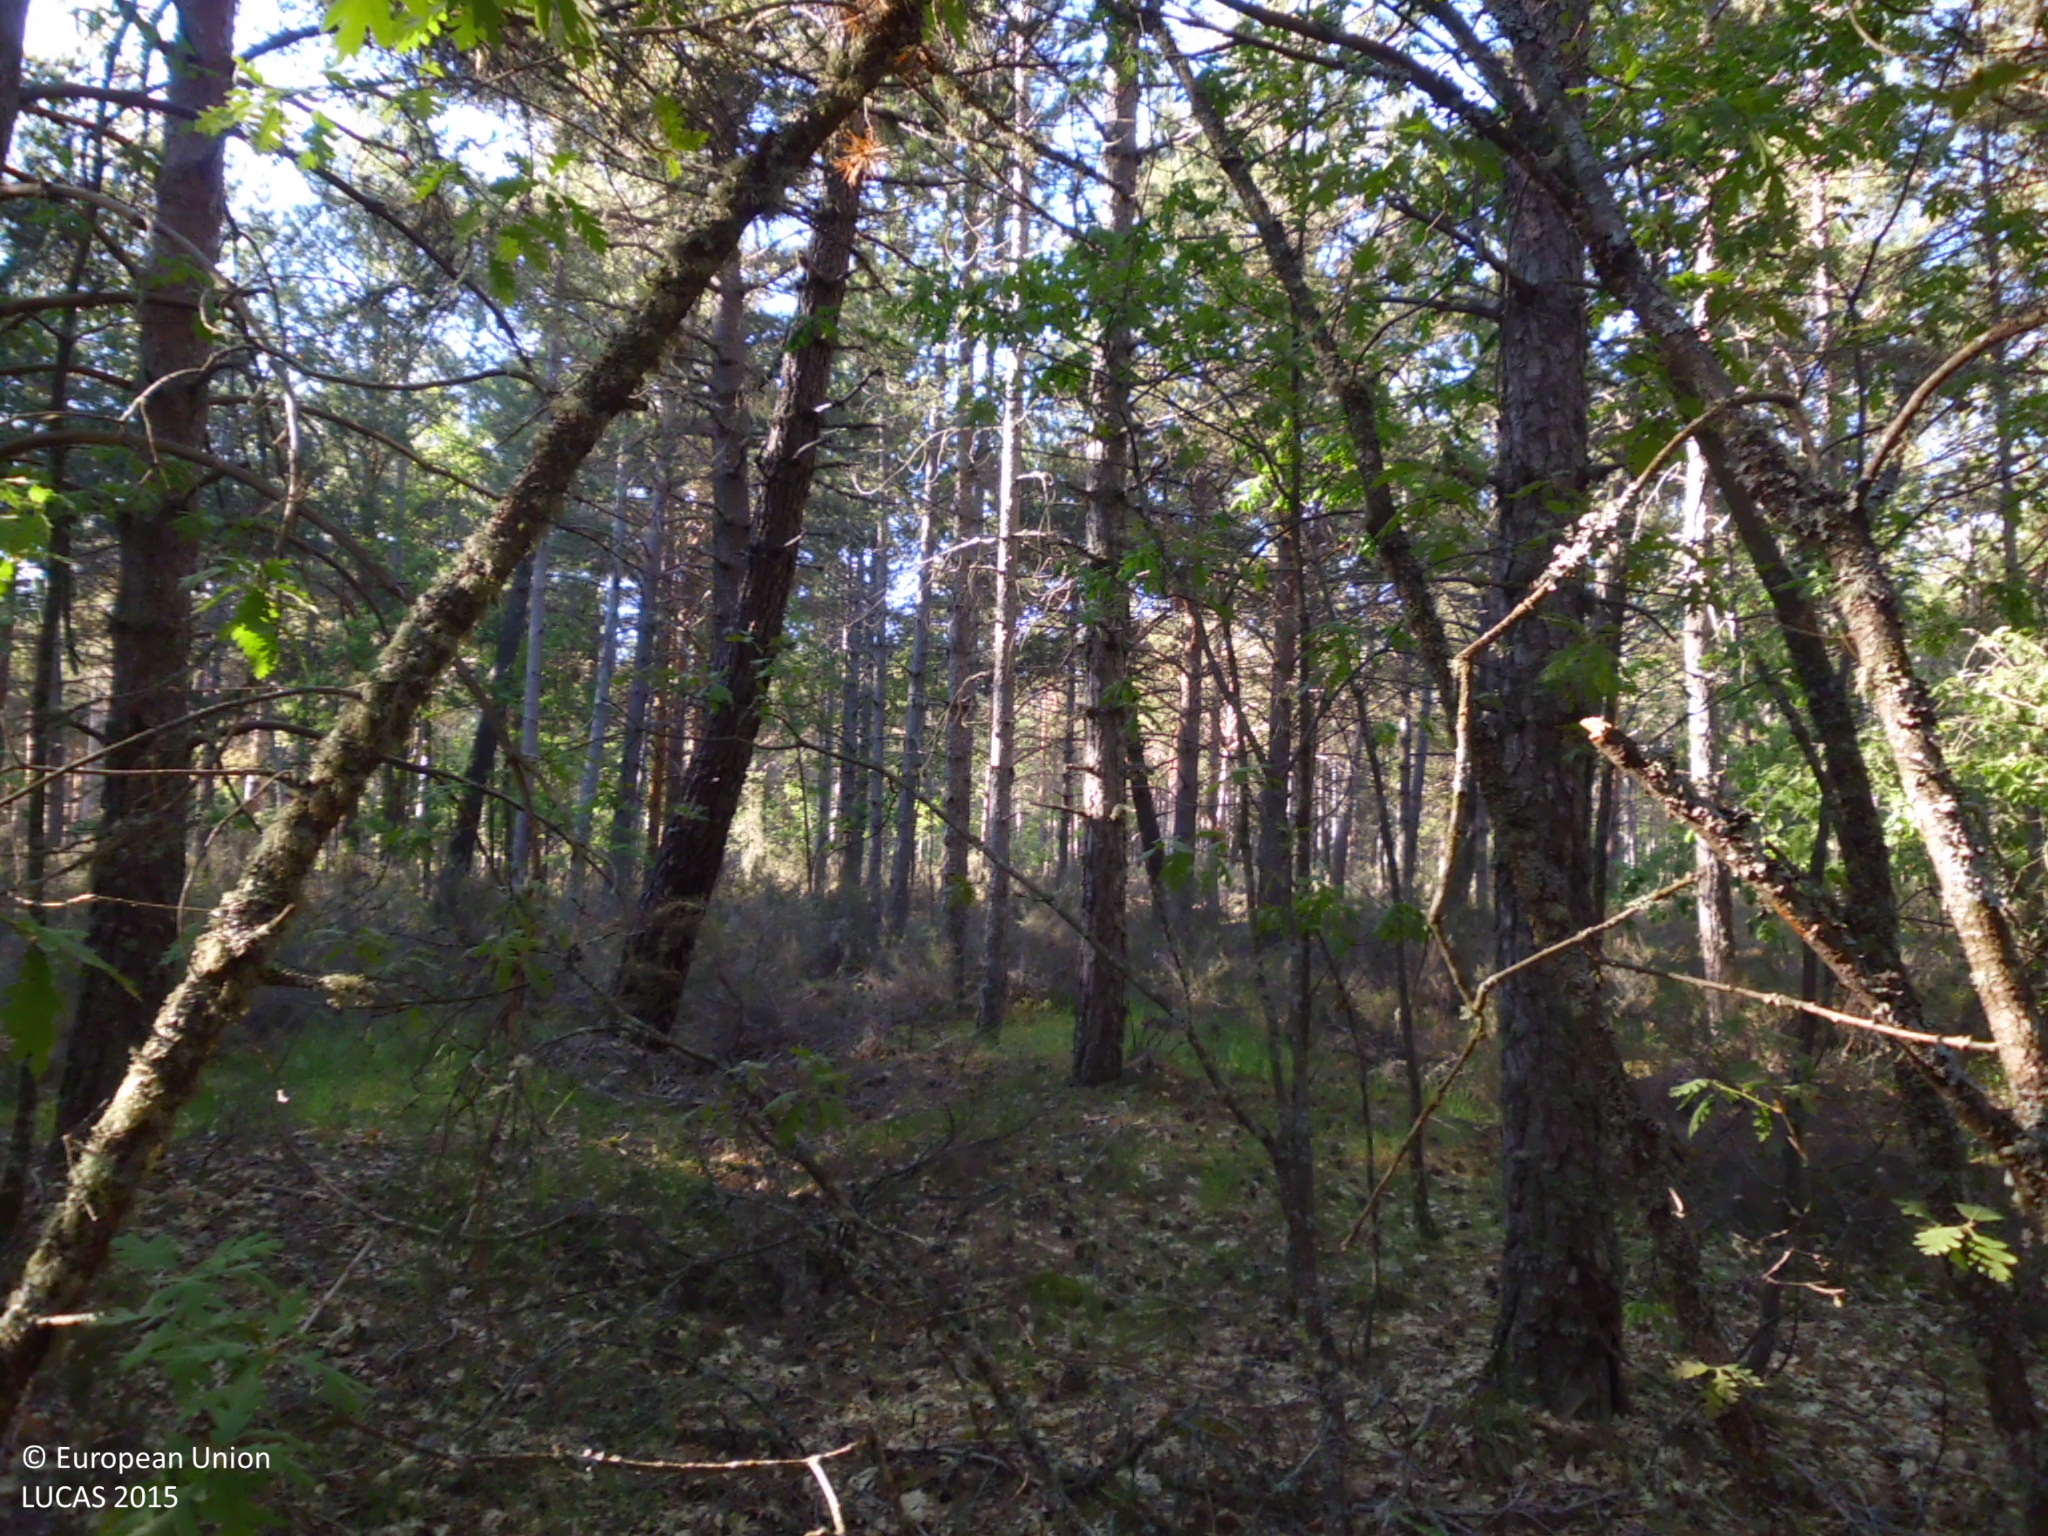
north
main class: Woodland
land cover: Pine dominated coniferous woodland
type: coniferous forest of the mediterranean region
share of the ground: > 75 %
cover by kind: coniferous forest trees 100 %
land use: Forestry
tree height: > 5 m
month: May
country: ES
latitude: 42.6866
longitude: -4.8643
